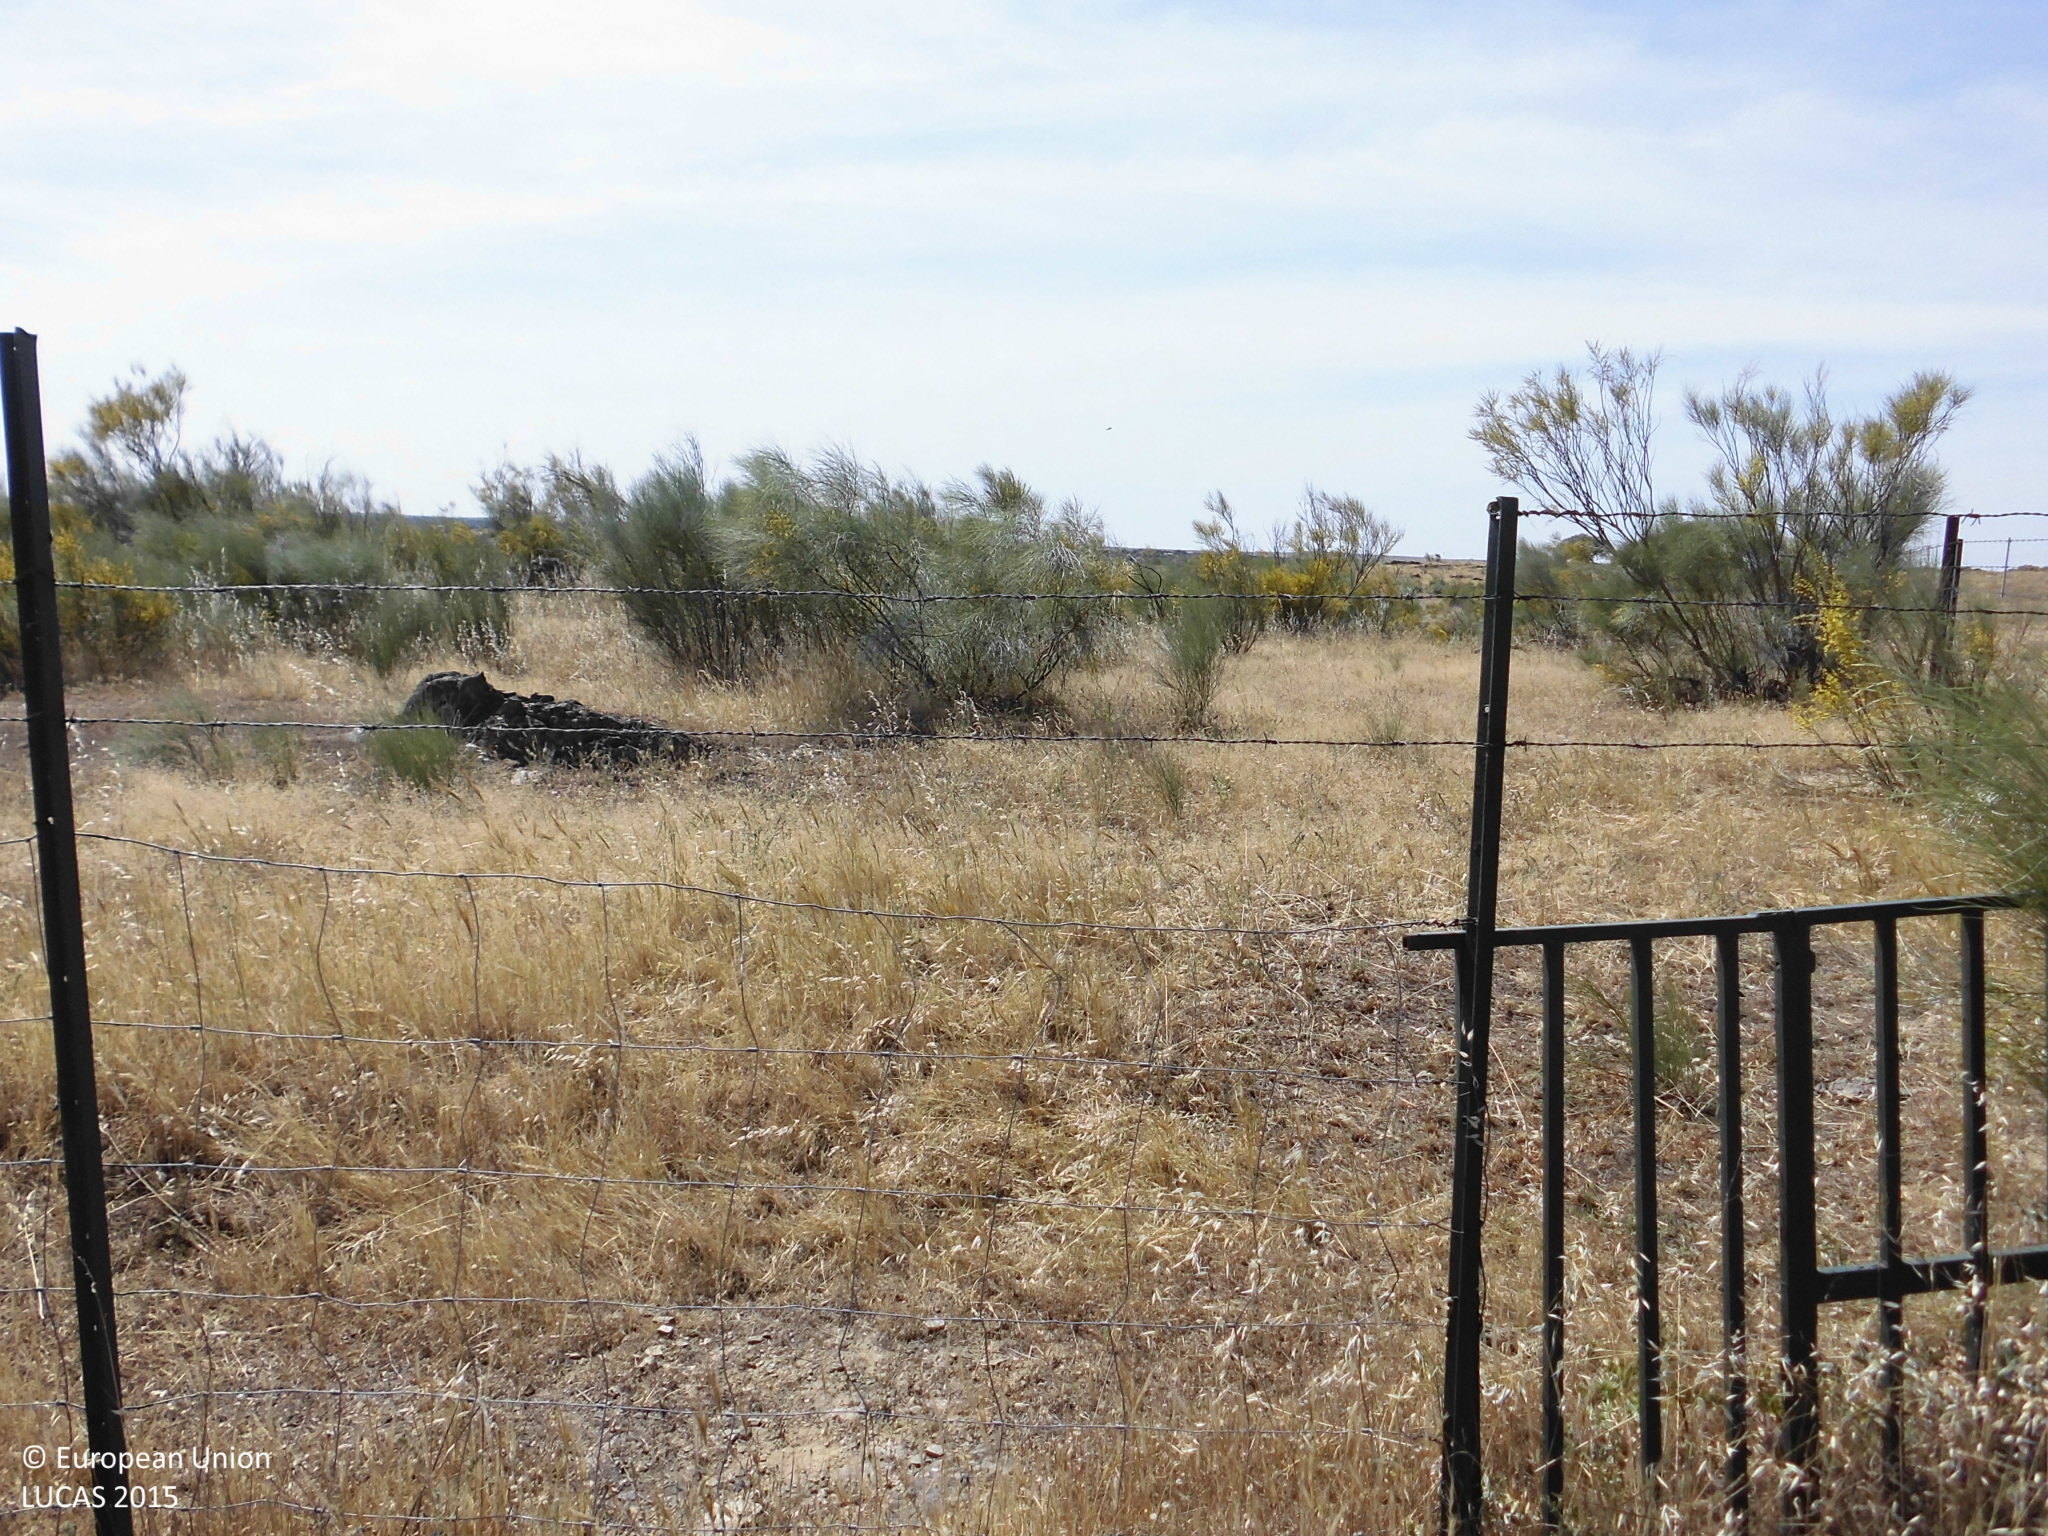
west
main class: Shrubland
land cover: Shrubland without tree cover
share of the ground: 10 - 25 %
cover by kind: herbaceous plants 85 %, shrubs 15 %
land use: Agriculture (excluding fallow land and kitchen gardens)
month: May
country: ES
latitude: 39.4456
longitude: -6.0856
